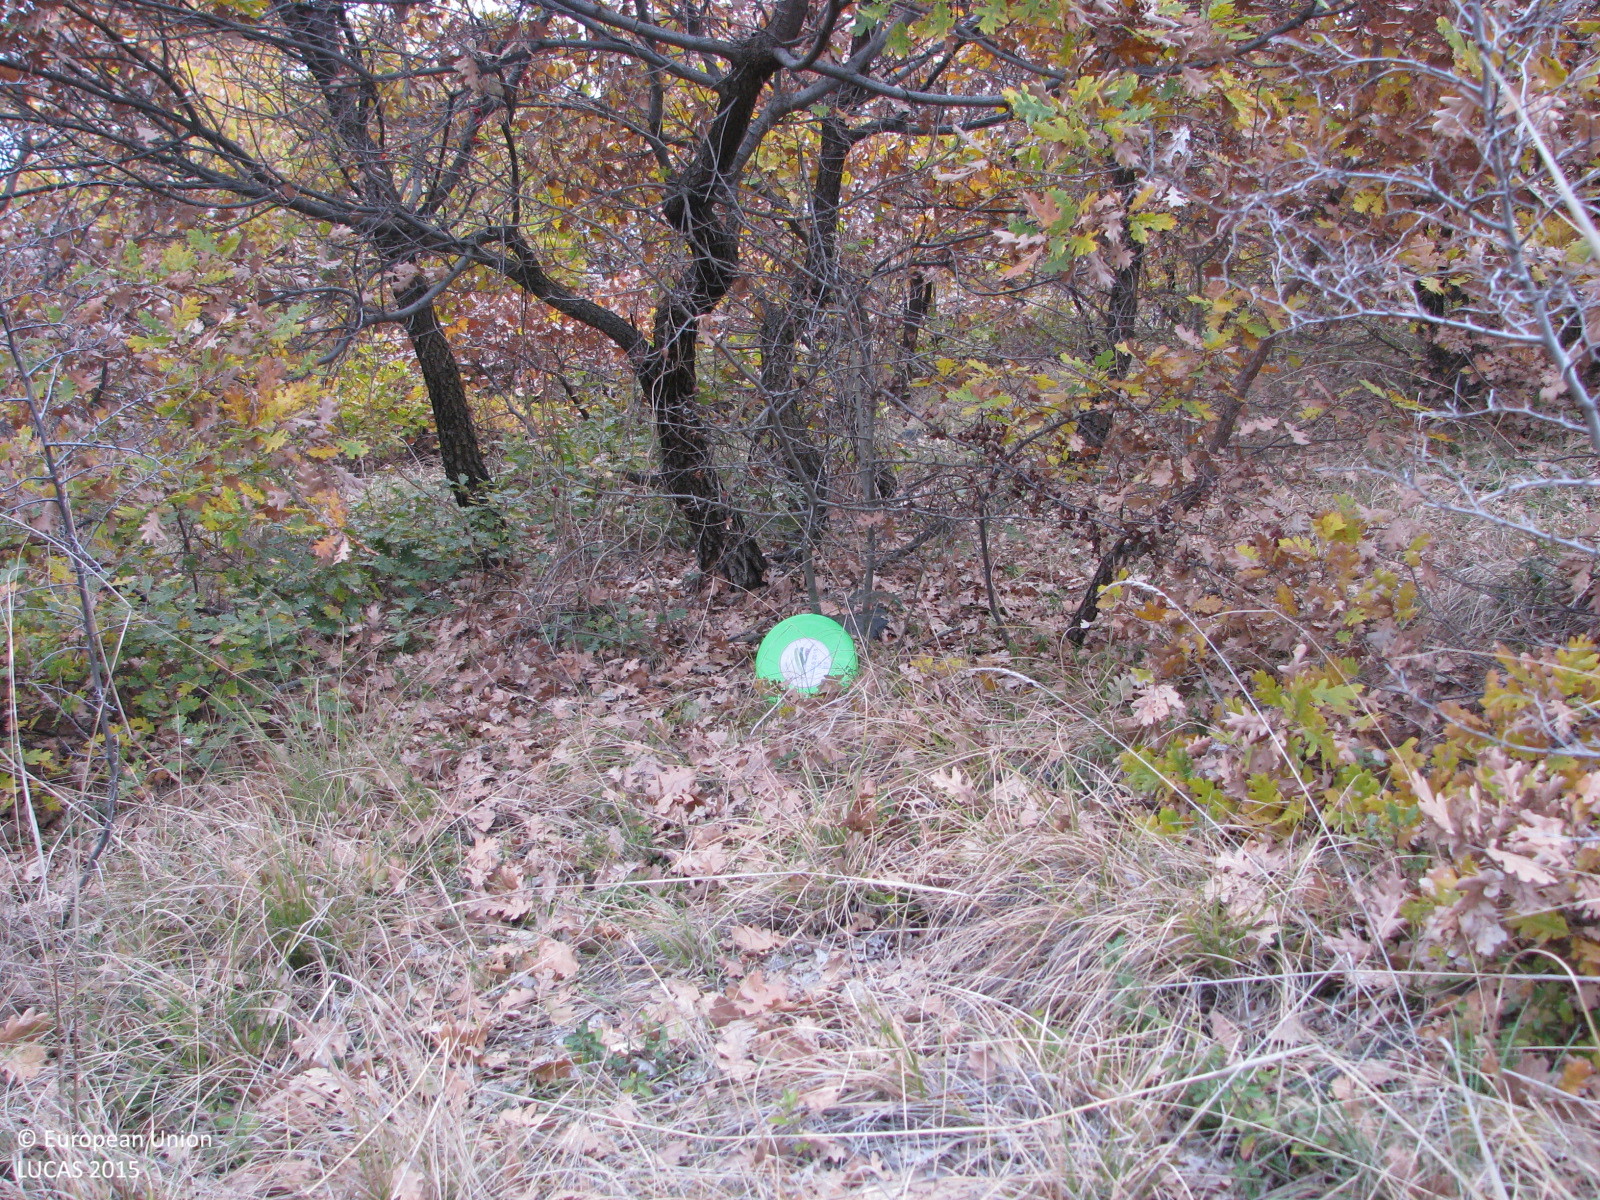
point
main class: Woodland
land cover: Broadleaved woodland
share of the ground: > 75 %
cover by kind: broadleaved forest trees 75 %, herbaceous plants 15 %, shrubs 10 %
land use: Semi-natural and natural areas not in use
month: December
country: BG
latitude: 42.2638
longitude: 24.1167
